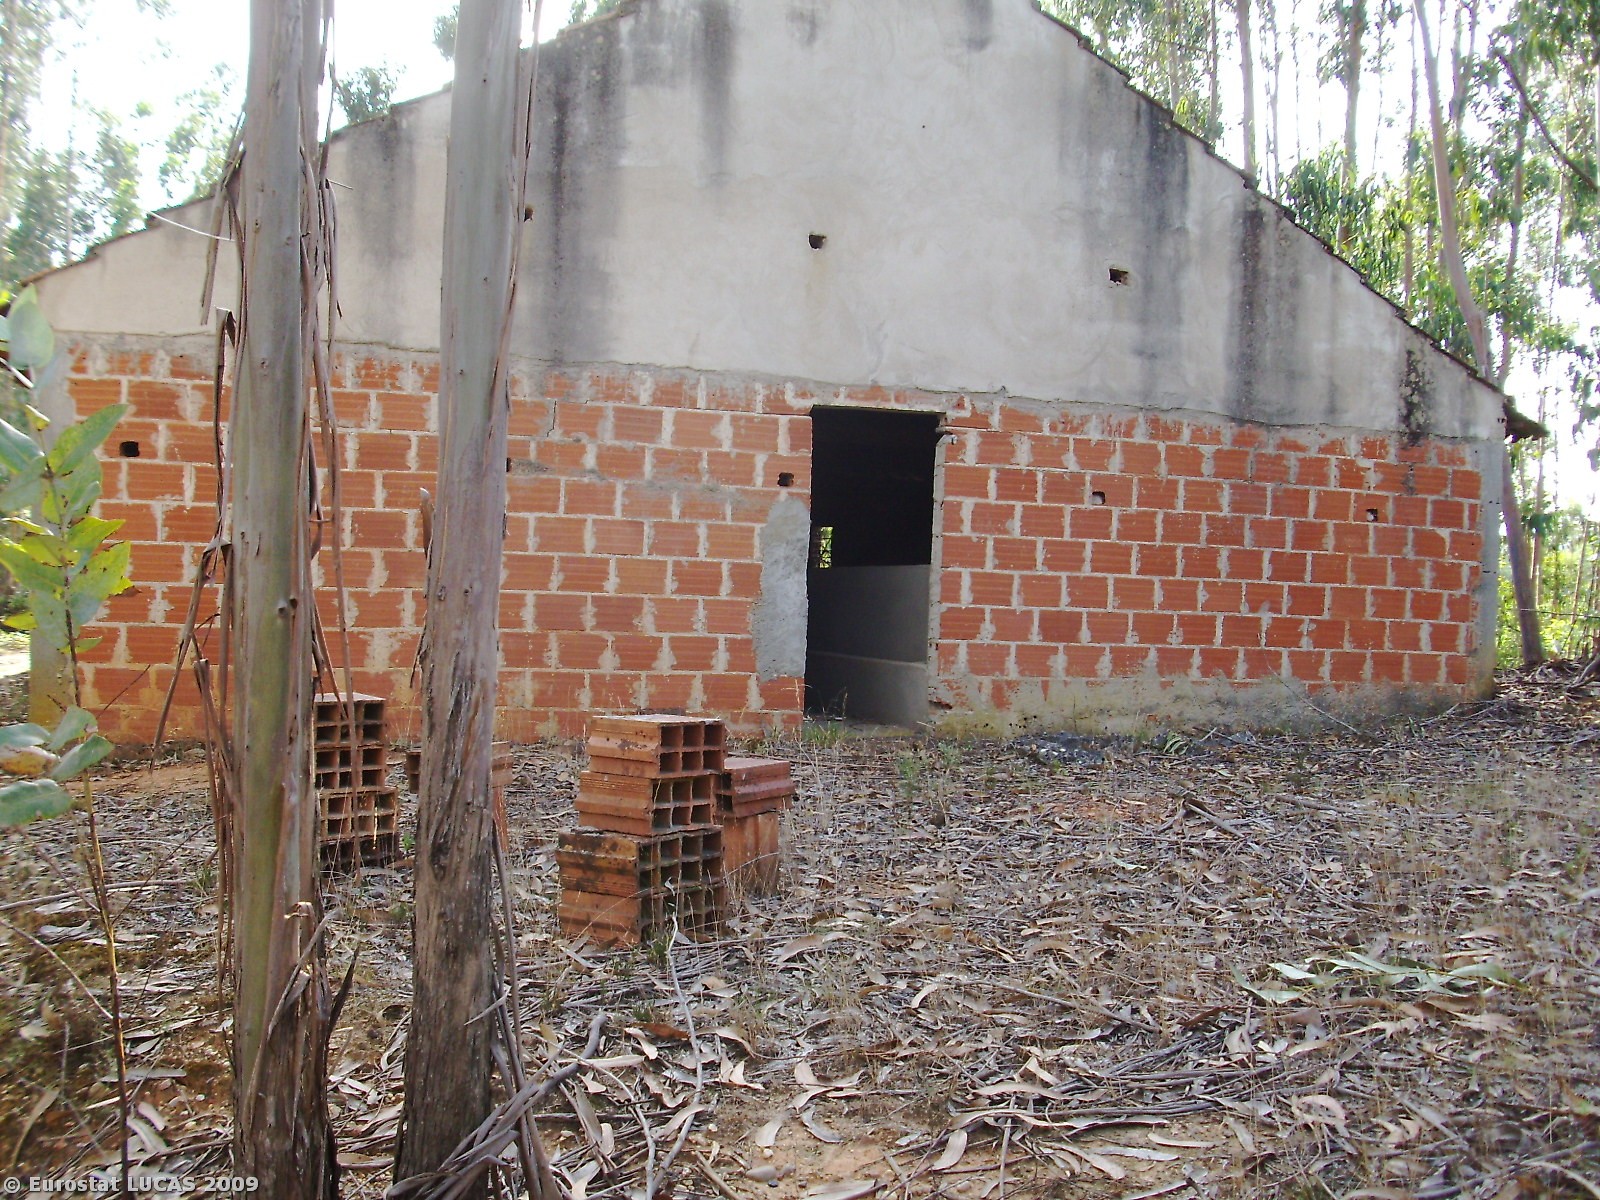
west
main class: Woodland
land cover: Broadleaved woodland
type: plantations and self-sown exotic forest
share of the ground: 50 - 75 %
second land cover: Bare land
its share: 25 - 50 %
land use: Forestry
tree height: > 5 m
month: July
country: PT
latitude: 39.3662
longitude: -8.8478
